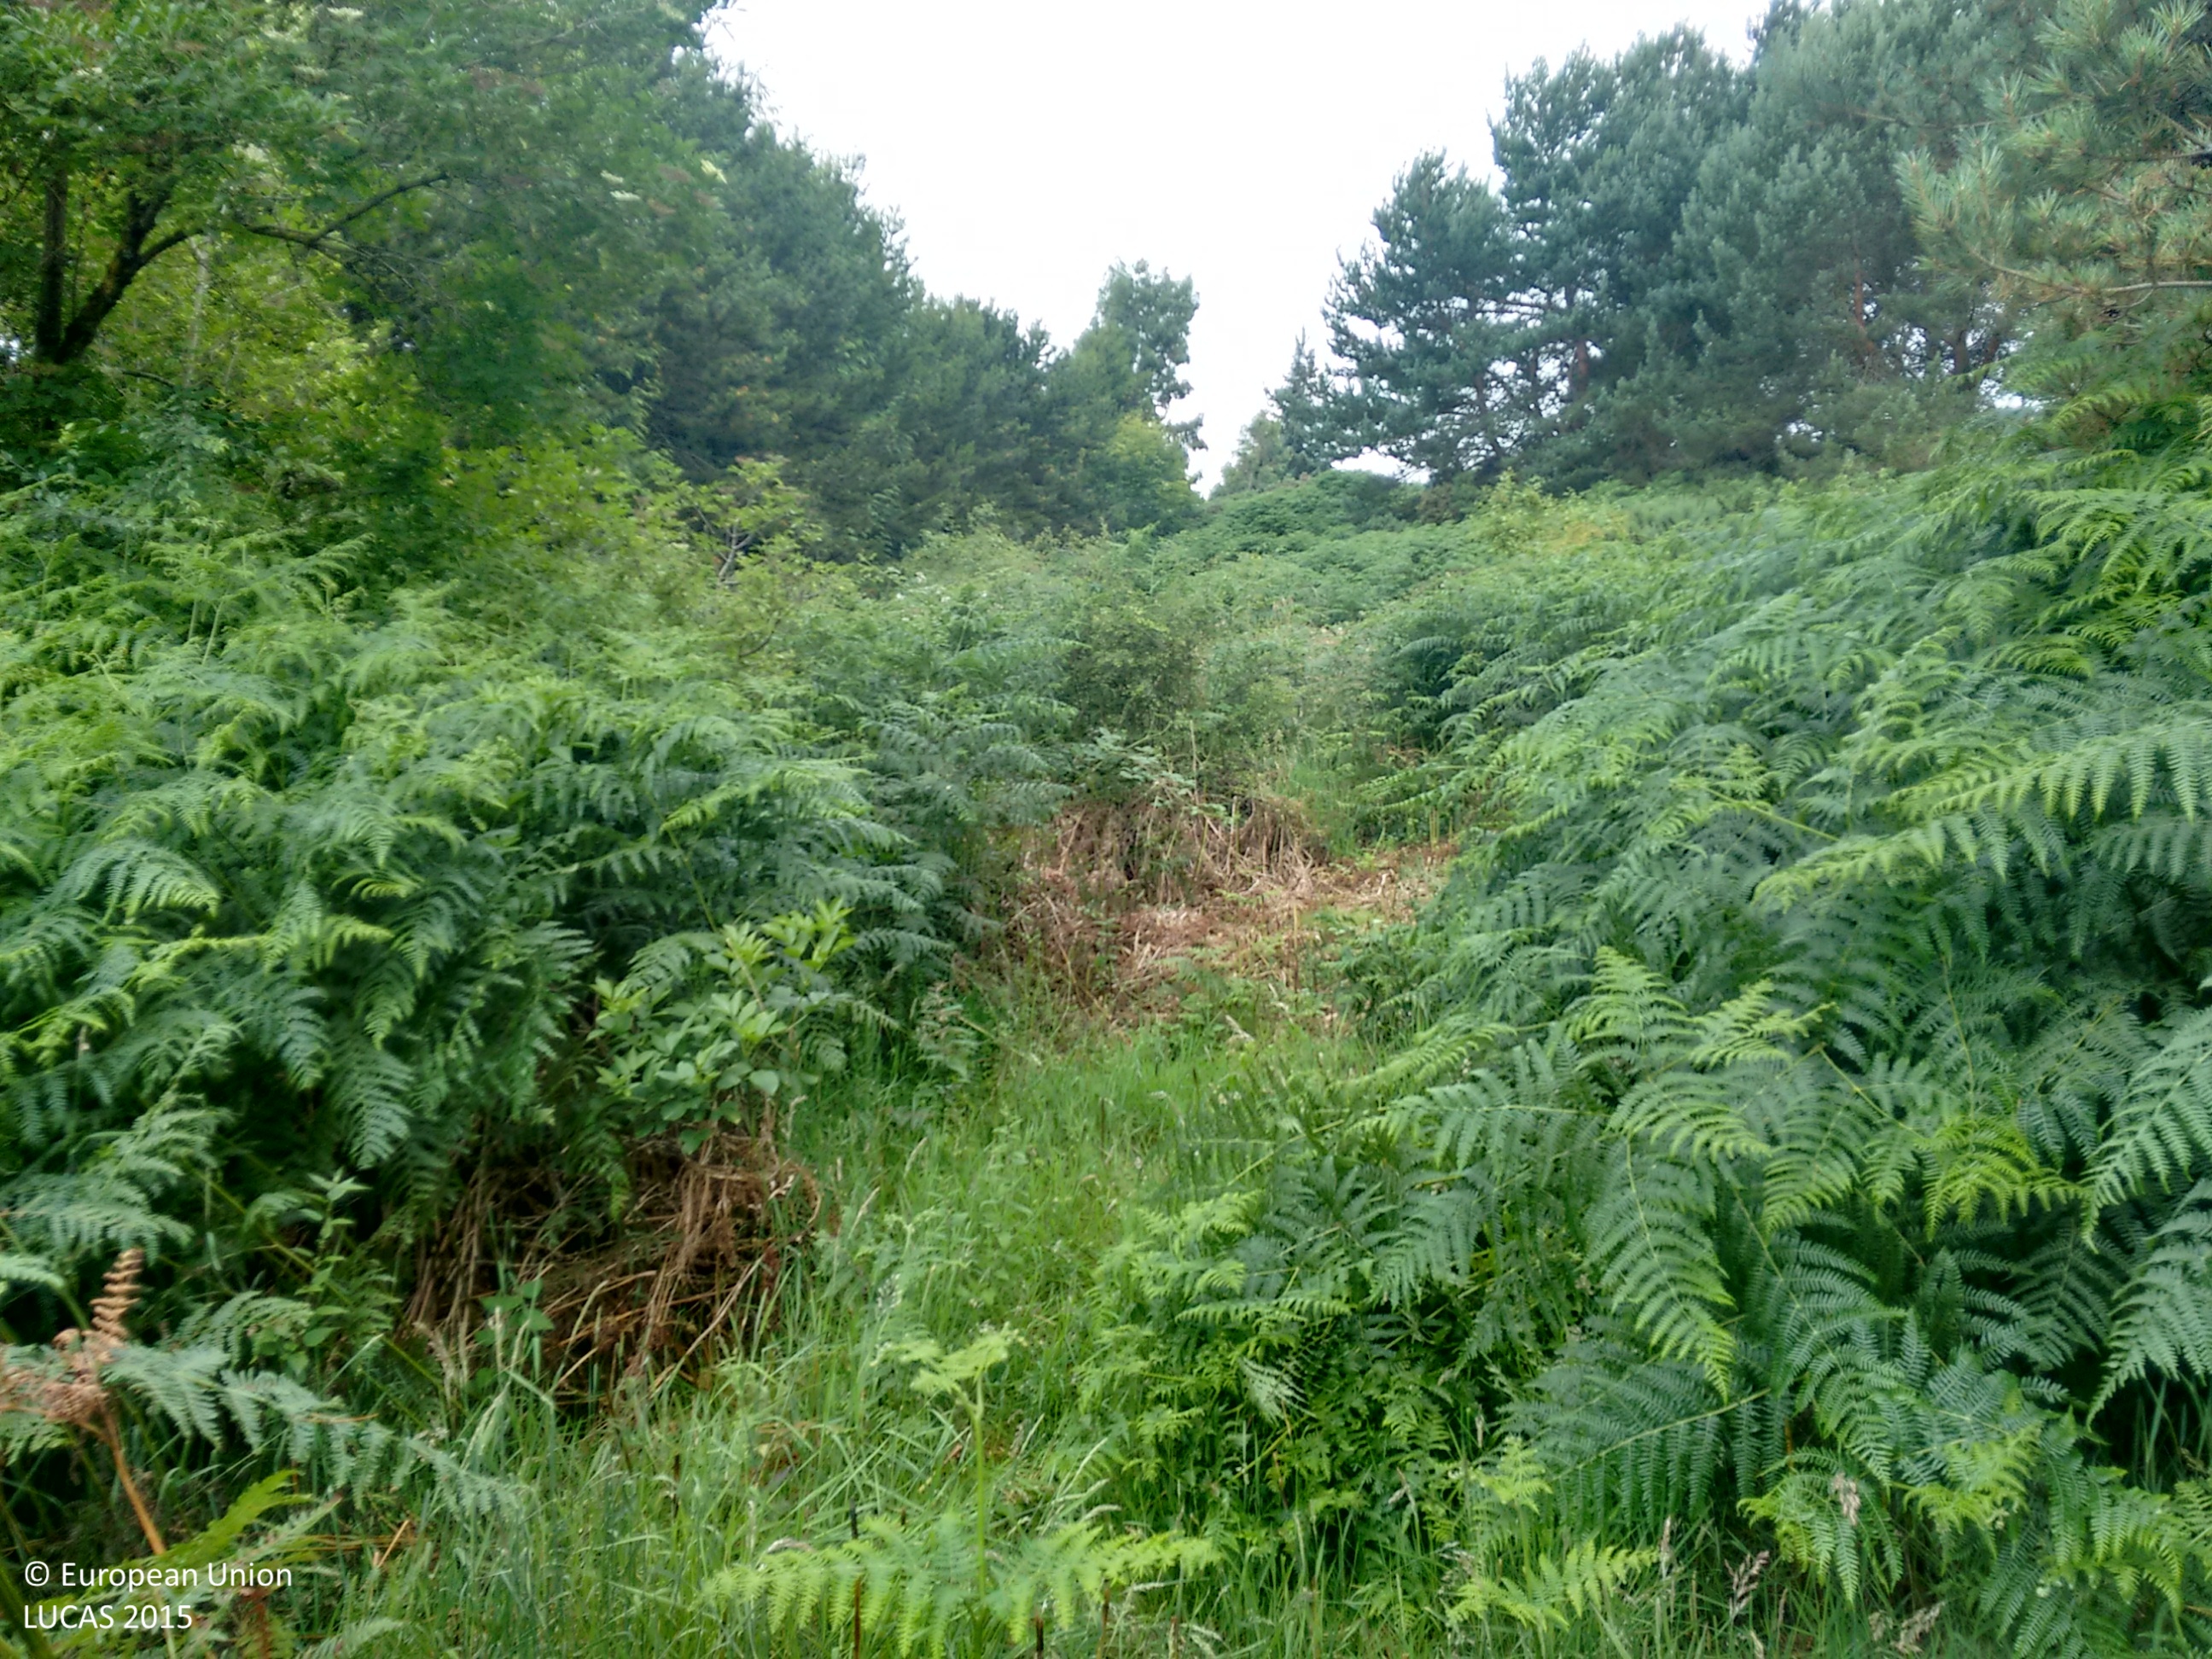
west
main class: Woodland
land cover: Other mixed woodland
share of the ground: > 75 %
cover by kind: coniferous forest trees 35 %, broadleaved forest trees 35 %, herbaceous plants 20 %, shrubs 10 %
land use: Residential
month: August
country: GB
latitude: 57.4701
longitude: -4.2755
